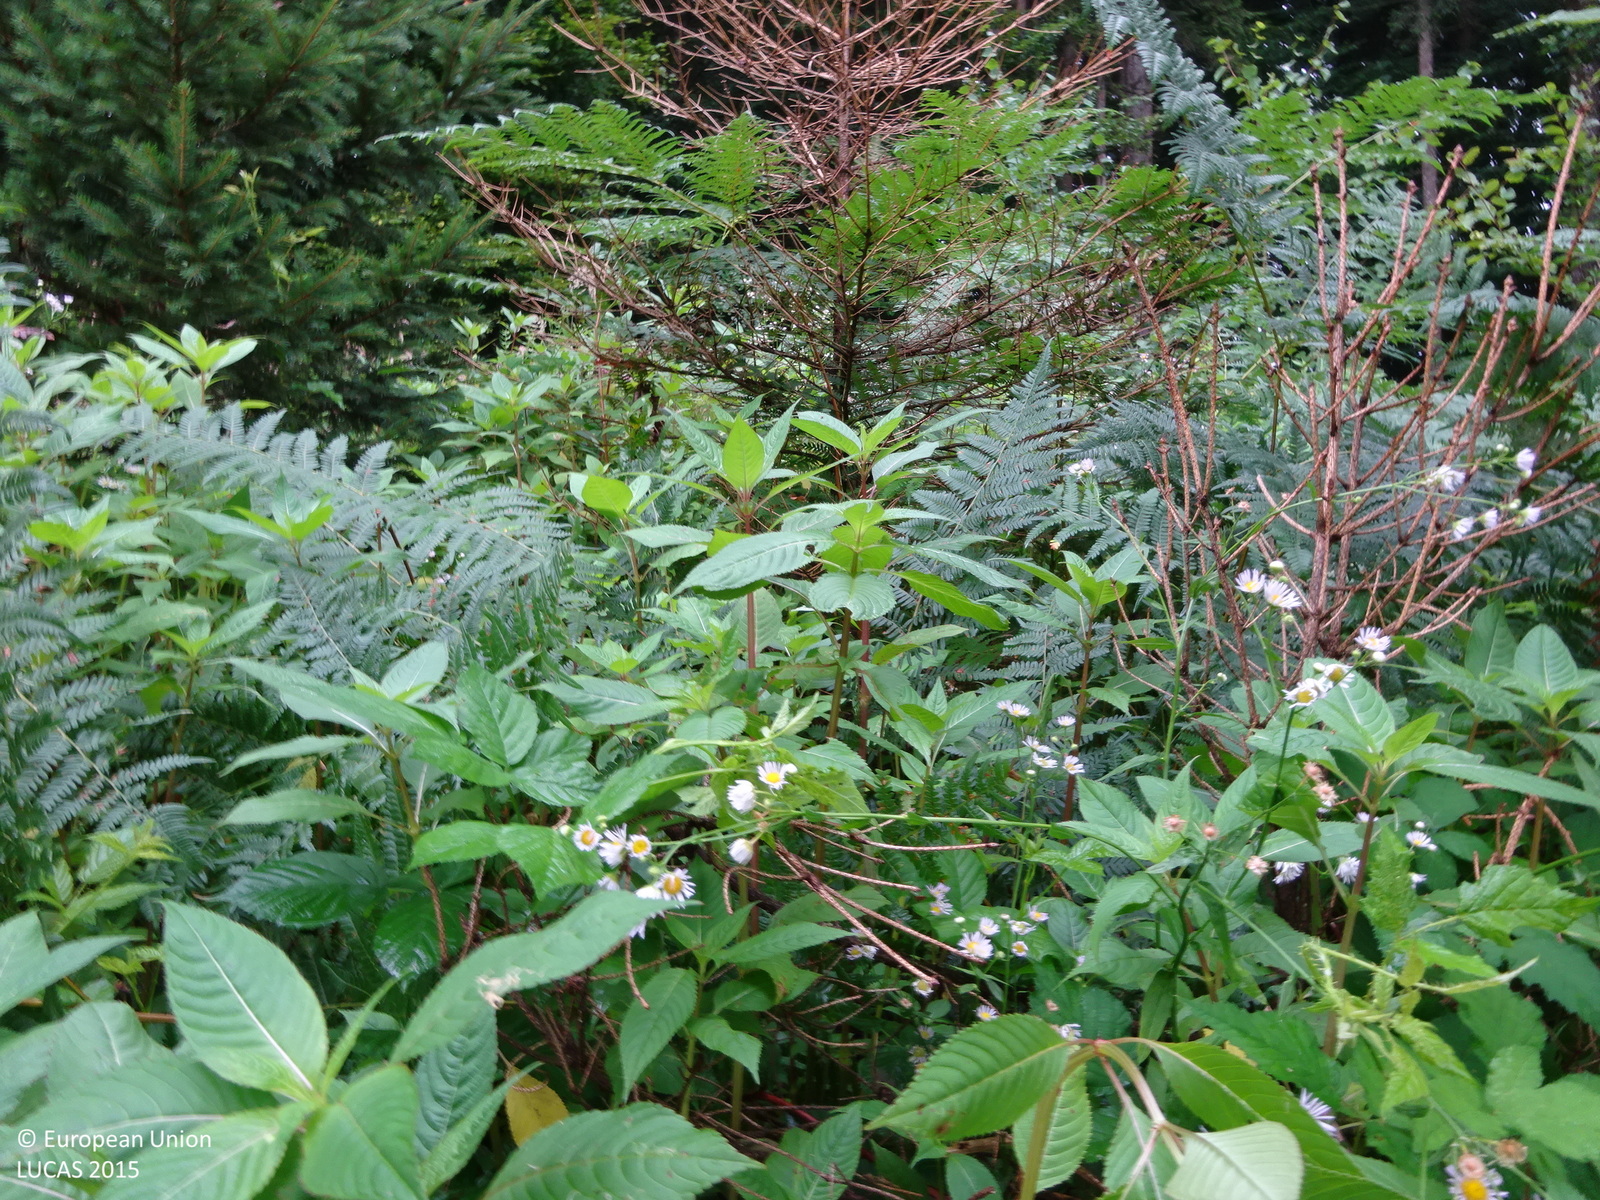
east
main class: Woodland
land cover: Spruce dominated coniferous woodland
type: alpine coniferous forest
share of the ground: 50 - 75 %
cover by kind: coniferous forest trees 60 %, herbaceous plants 20 %, broadleaved forest trees 10 %, shrubs 10 %
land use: Forestry
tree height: > 5 m
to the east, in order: Spruce dominated coniferous woodland; Tracks; Groves; Spruce dominated mixed woodland; Tracks; Spruce dominated mixed woodland; Rivers and streams; Spruce dominated coniferous woodland; Pine dominated mixed woodland; Electric lines; Tracks; Other mixed woodland
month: July
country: AT
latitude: 46.7984
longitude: 15.2791
